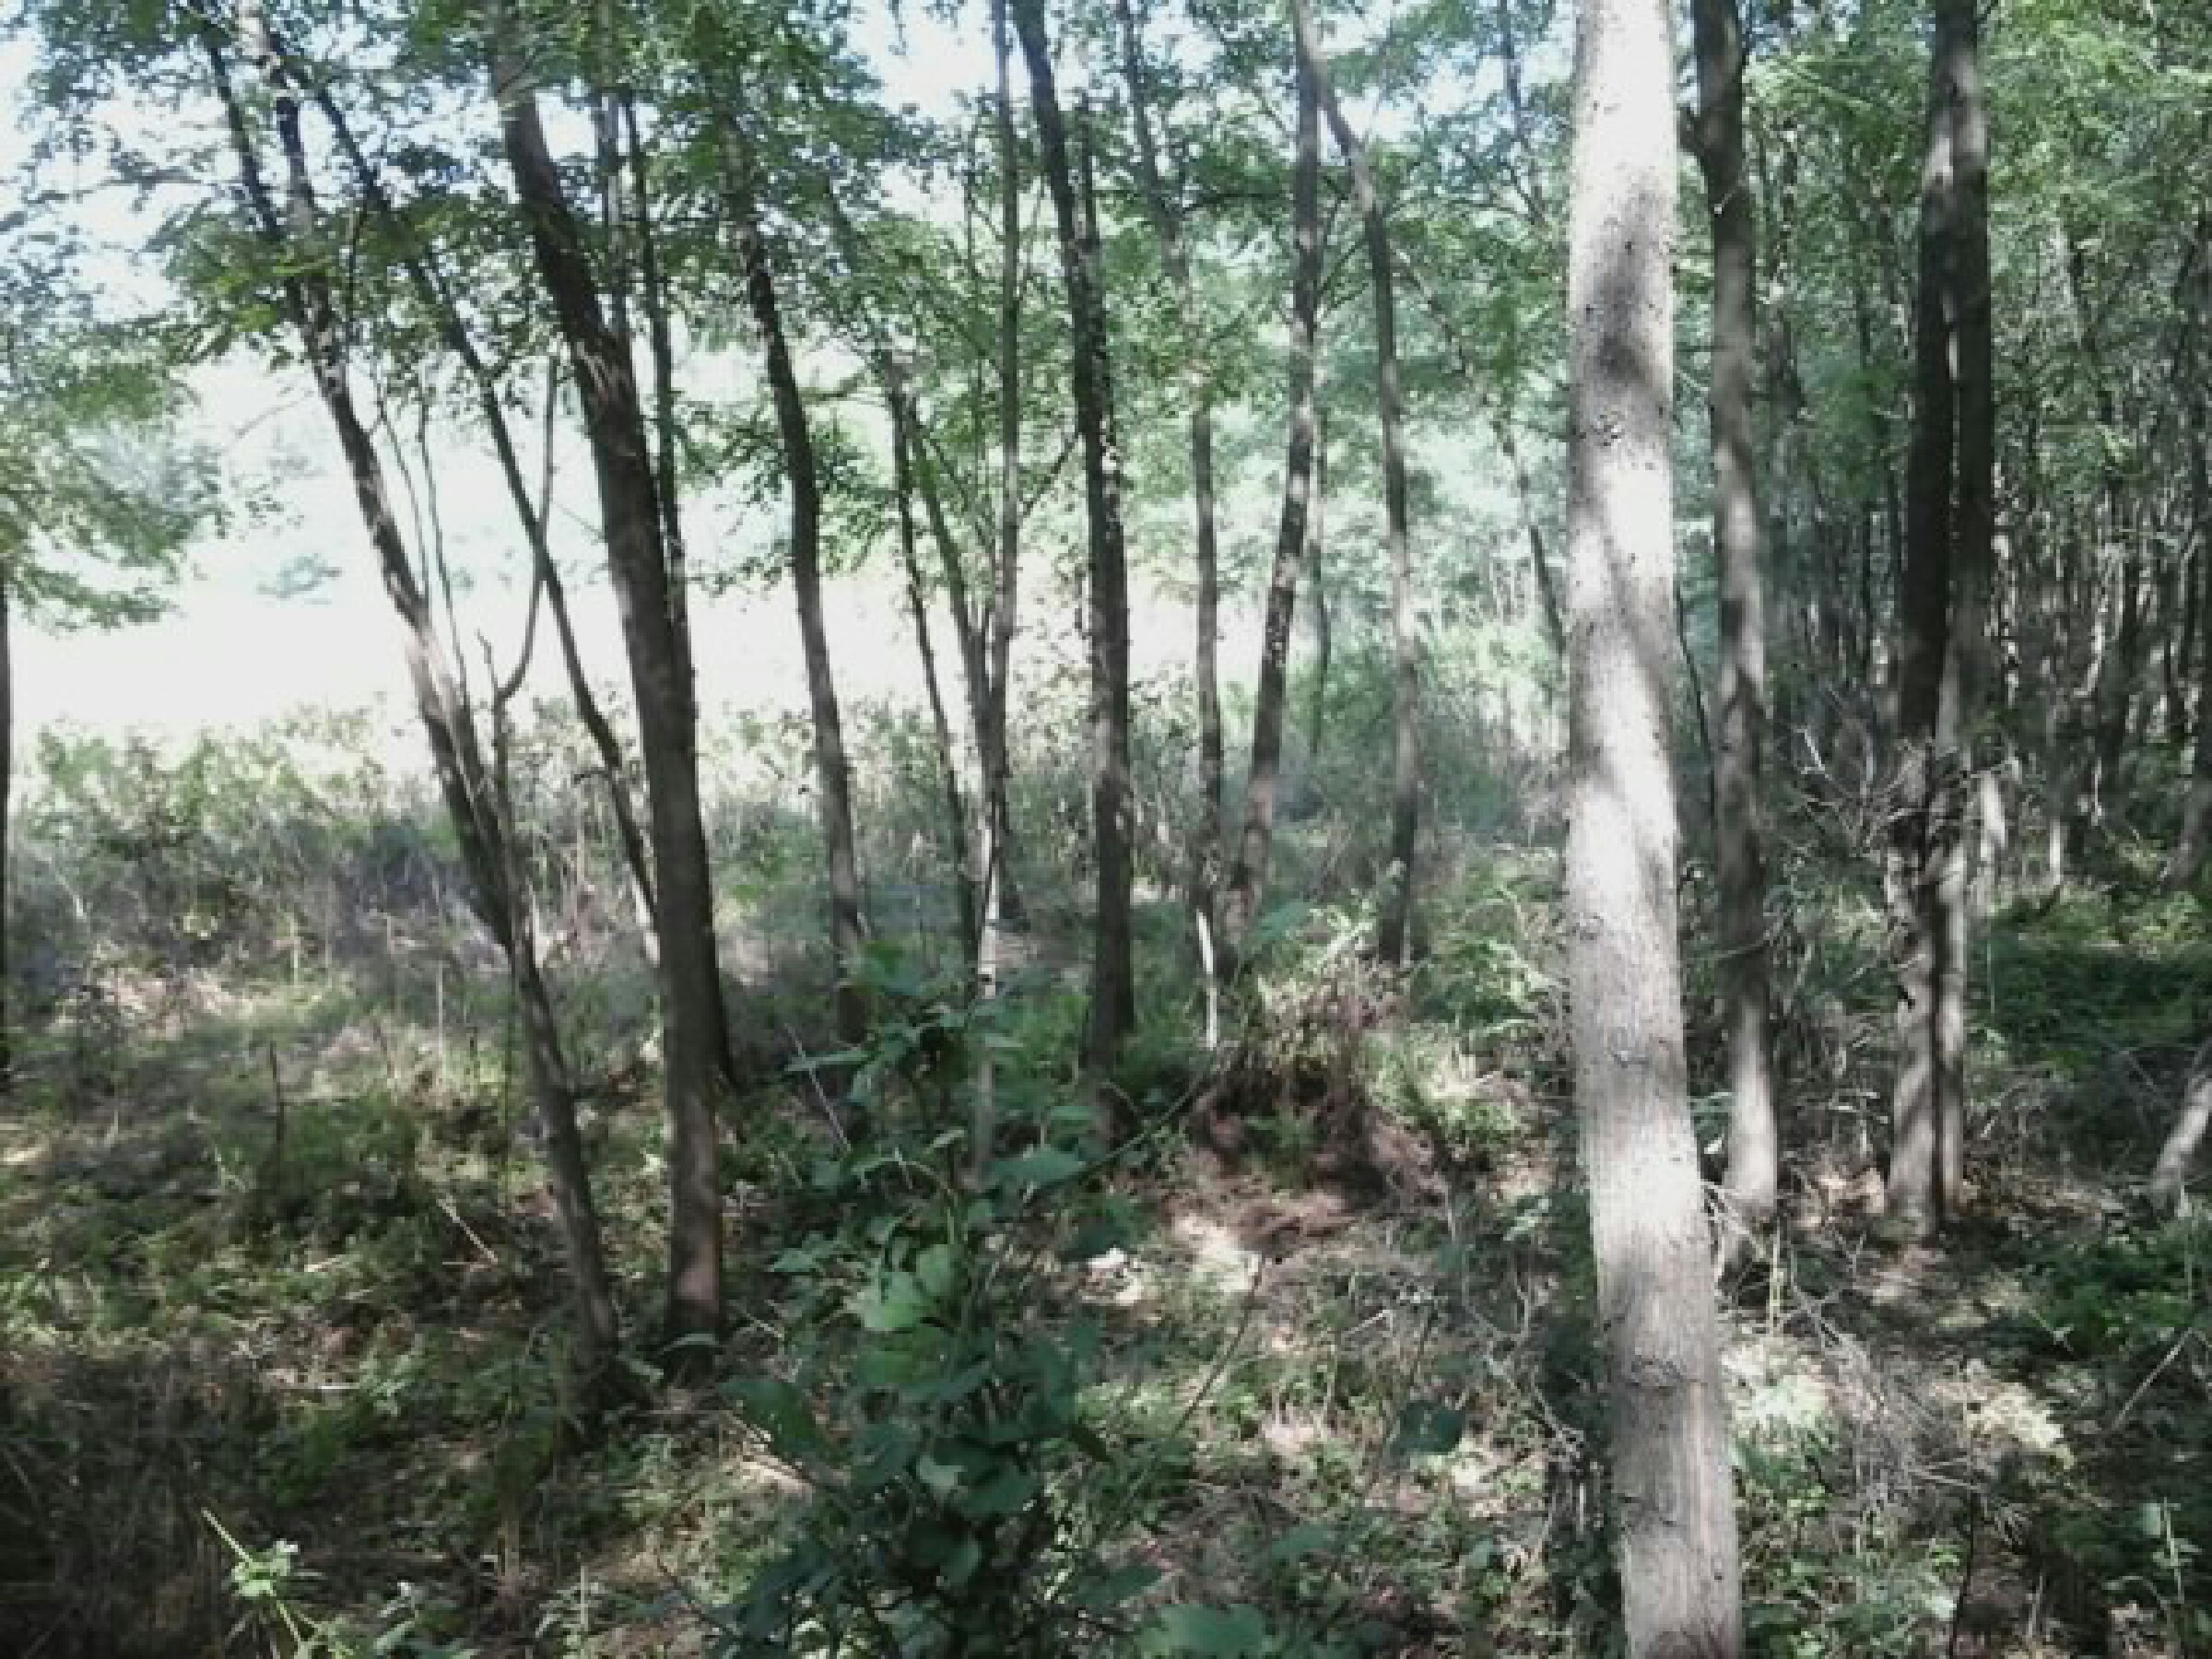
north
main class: Woodland
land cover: Broadleaved woodland
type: exotic forest
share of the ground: > 75 %
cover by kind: broadleaved forest trees 100 %
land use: Forestry
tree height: > 5 m
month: August
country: HU
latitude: 47.9317
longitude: 19.3781
